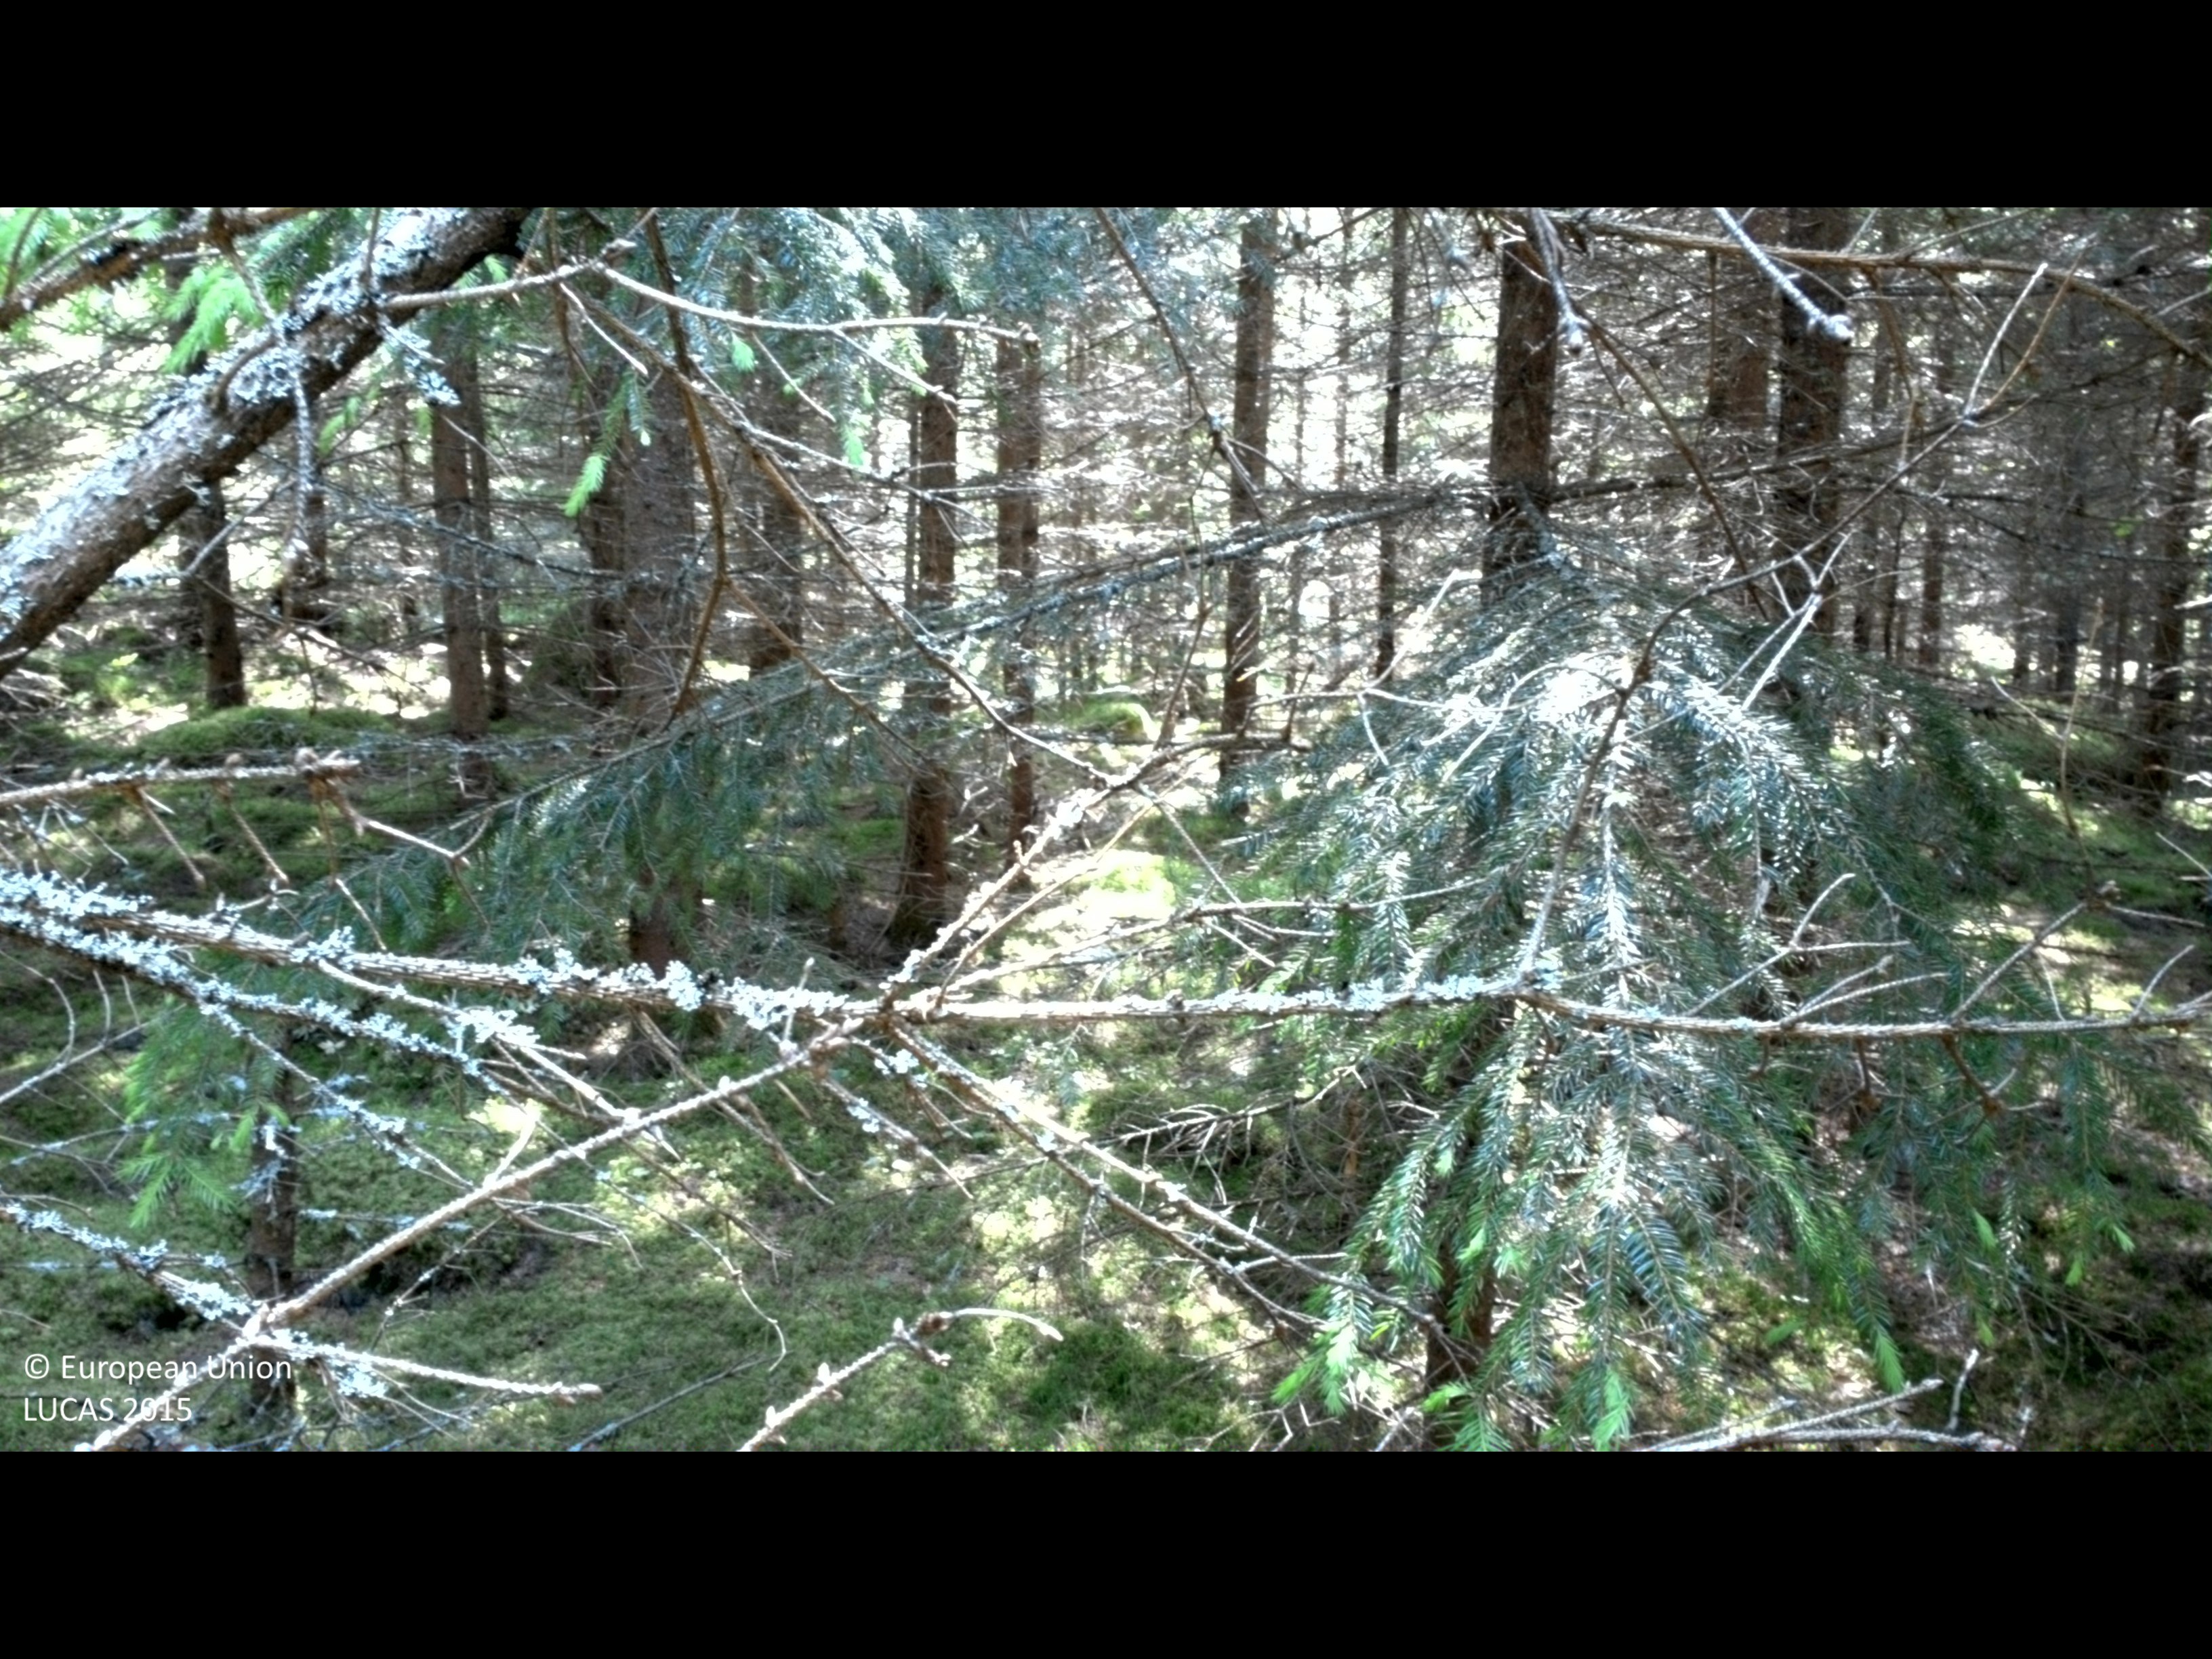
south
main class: Woodland
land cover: Spruce dominated coniferous woodland
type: boreal forest
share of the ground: > 75 %
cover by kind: coniferous forest trees 90 %, lichens and mosses 10 %
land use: Forestry
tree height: > 5 m
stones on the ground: > 50 %
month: June
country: SE
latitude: 58.1877
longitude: 16.1362
